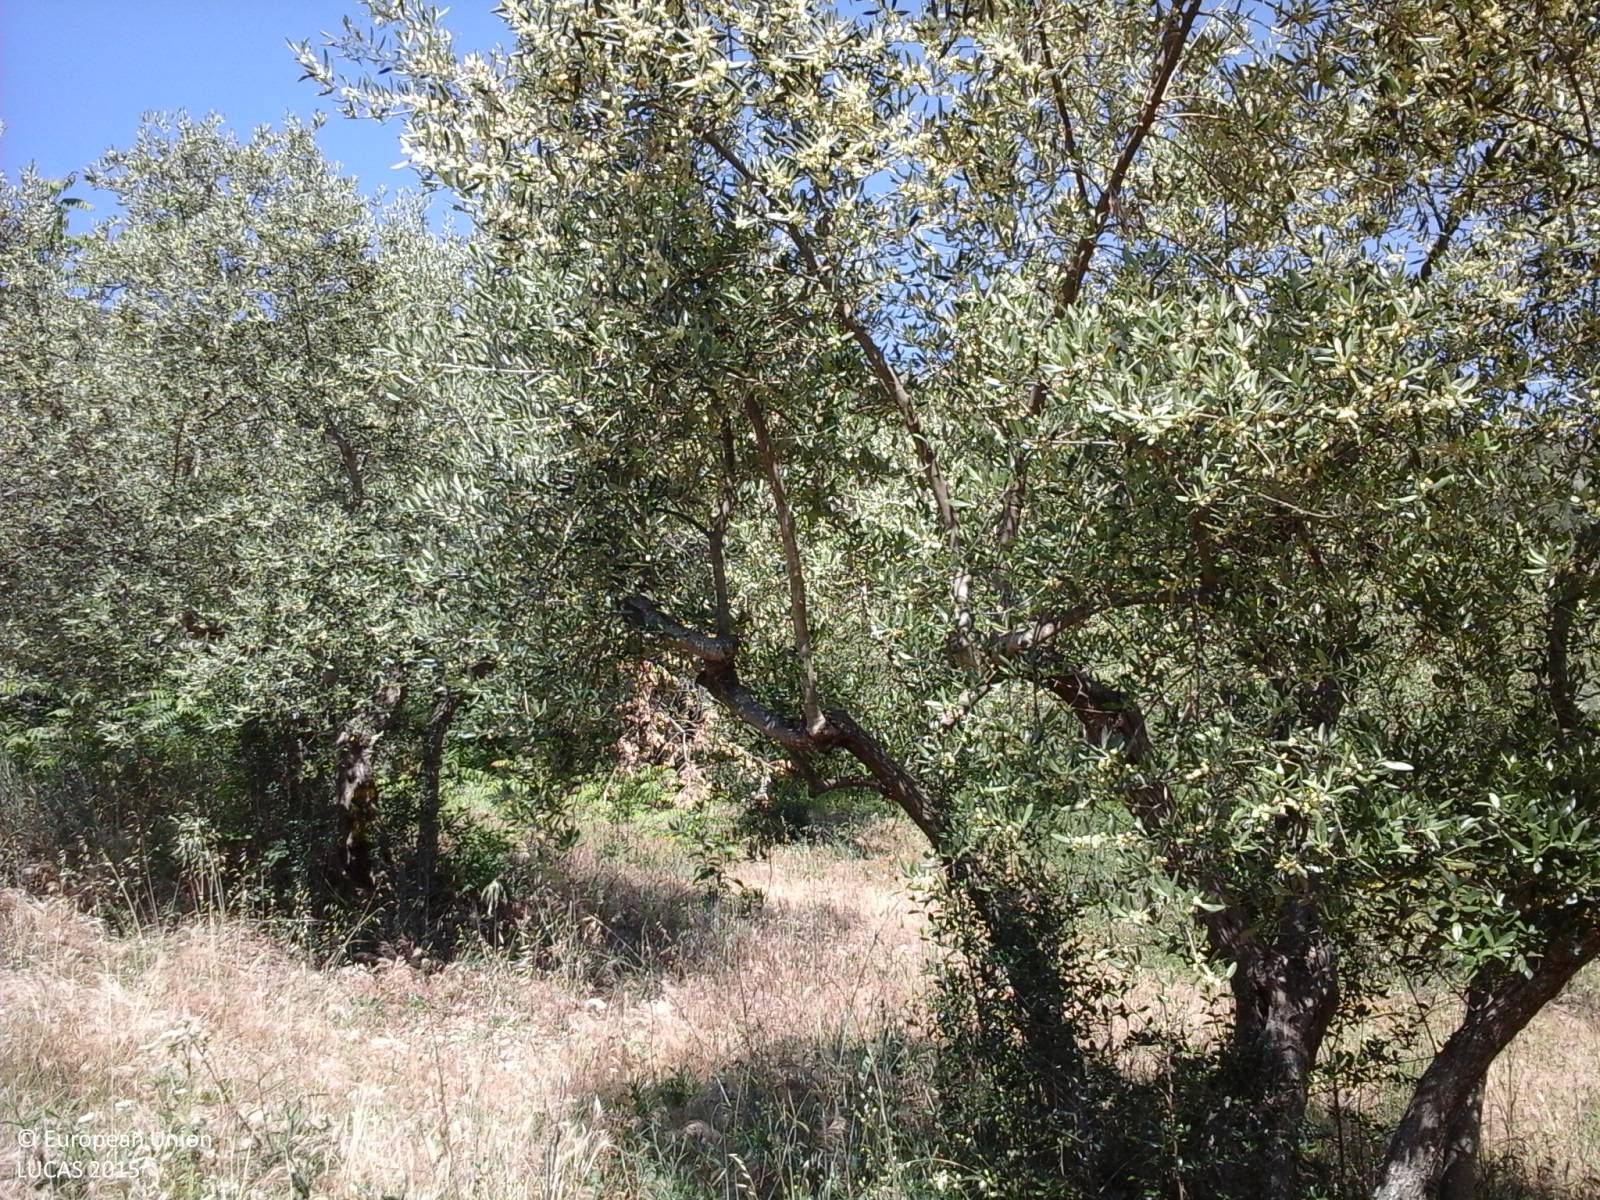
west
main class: Cropland
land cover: Olive groves
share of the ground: 25 - 50 %
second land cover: Spontaneously vegetated surfaces
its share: 50 - 75 %
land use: Abandoned areas
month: June
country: IT
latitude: 42.0757
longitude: 13.8189
